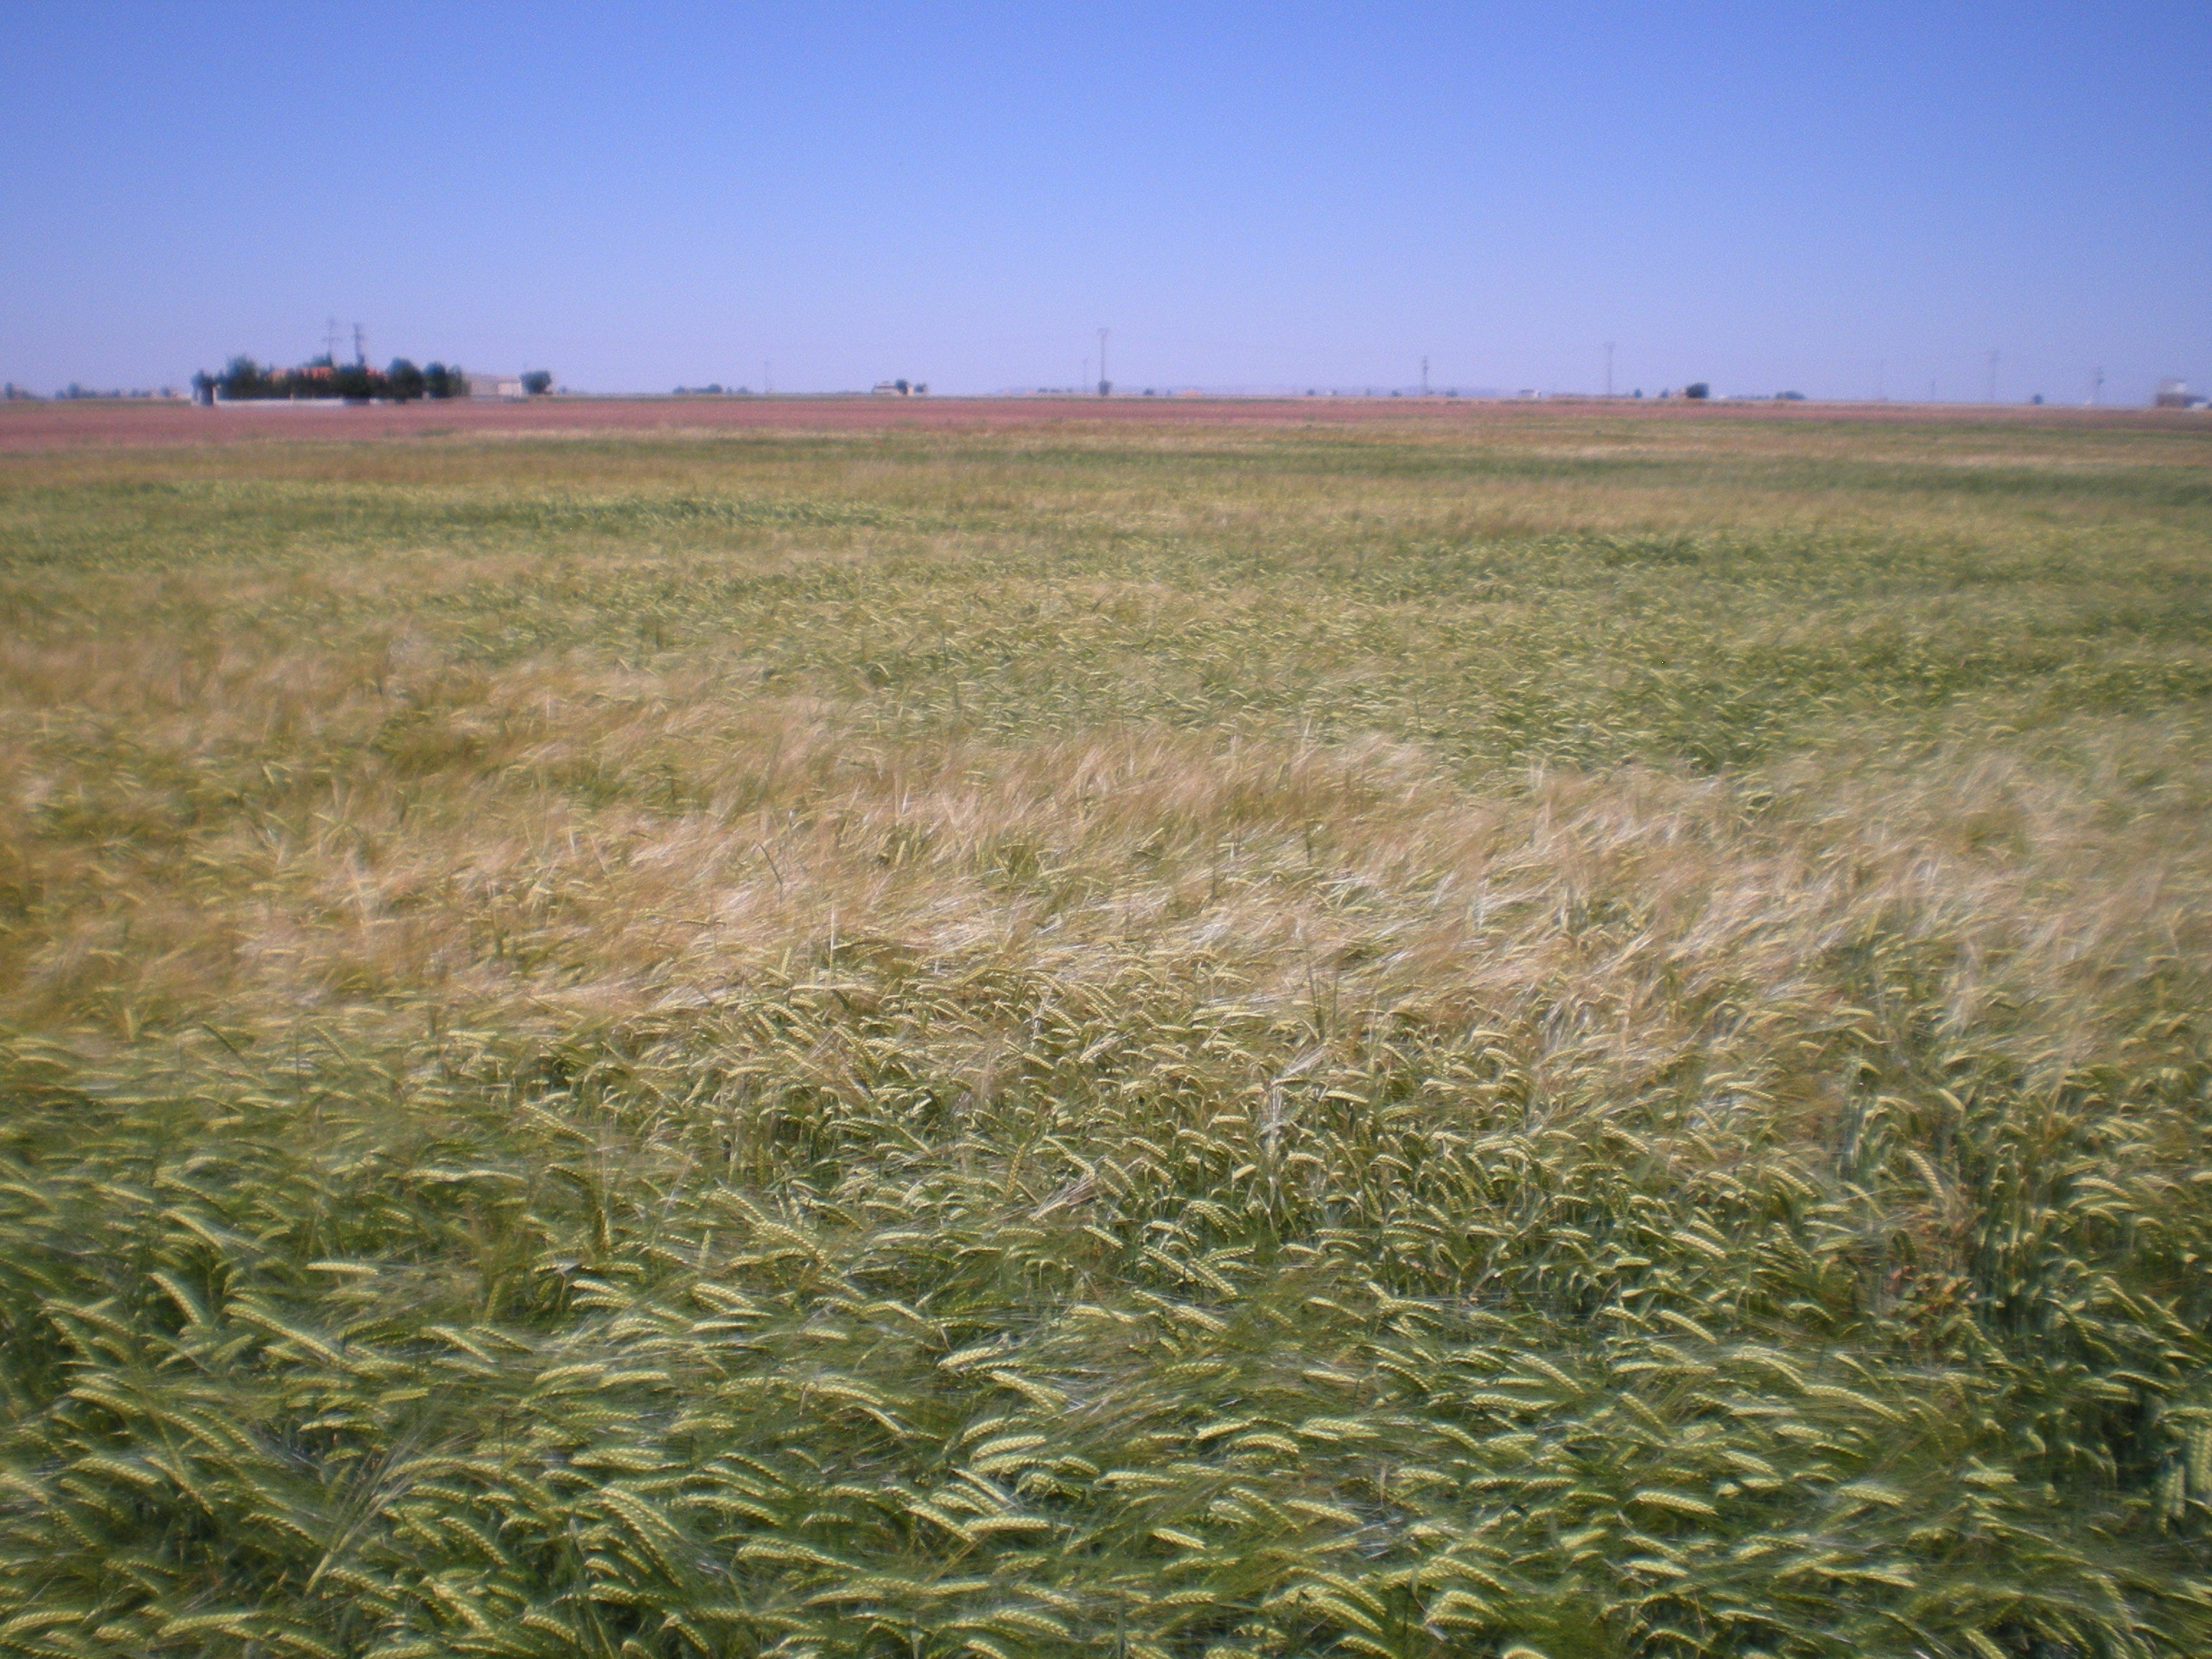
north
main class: Cropland
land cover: Barley
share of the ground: > 75 %
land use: Agriculture (excluding fallow land and kitchen gardens)
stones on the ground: 10 - 25 %
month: May
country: ES
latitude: 39.1437
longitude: -3.1225
